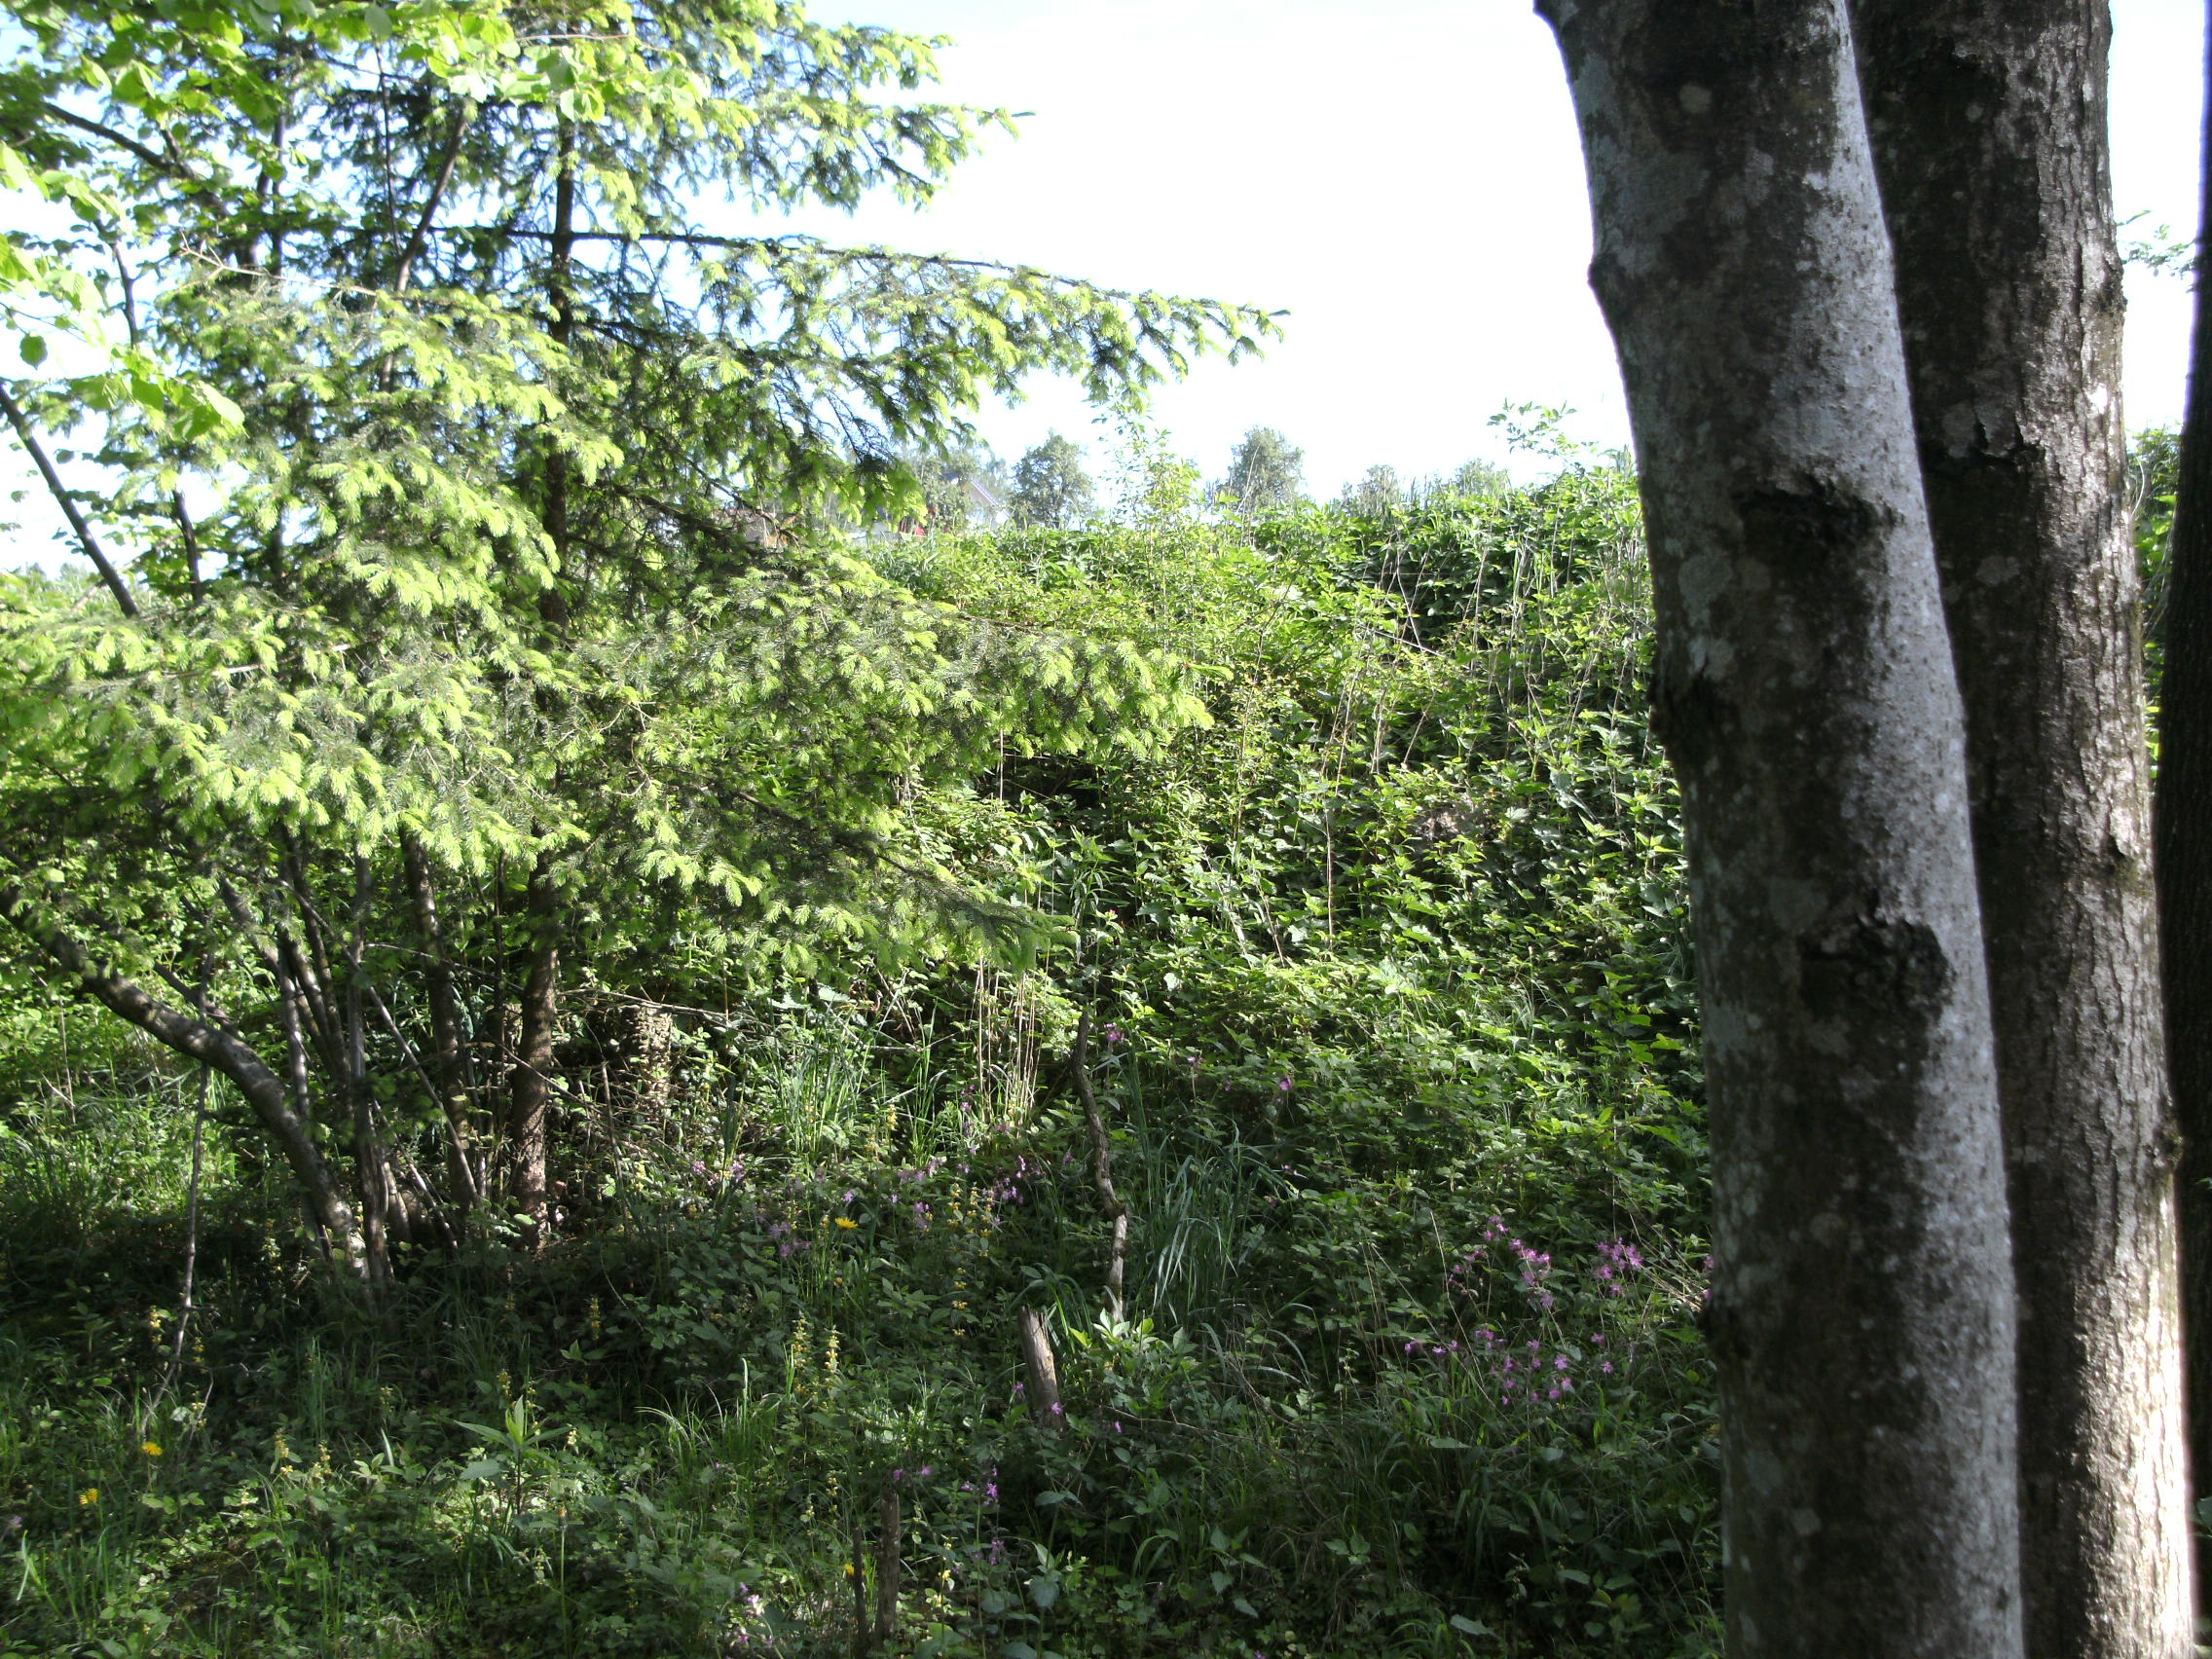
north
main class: Woodland
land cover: Other mixed woodland
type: mire and swamp forests
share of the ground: > 75 %
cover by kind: coniferous forest trees 45 %, broadleaved forest trees 45 %, shrubs 5 %, herbaceous plants 5 %
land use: Forestry
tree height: > 5 m
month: May
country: AT
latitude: 48.4390
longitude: 13.4735
